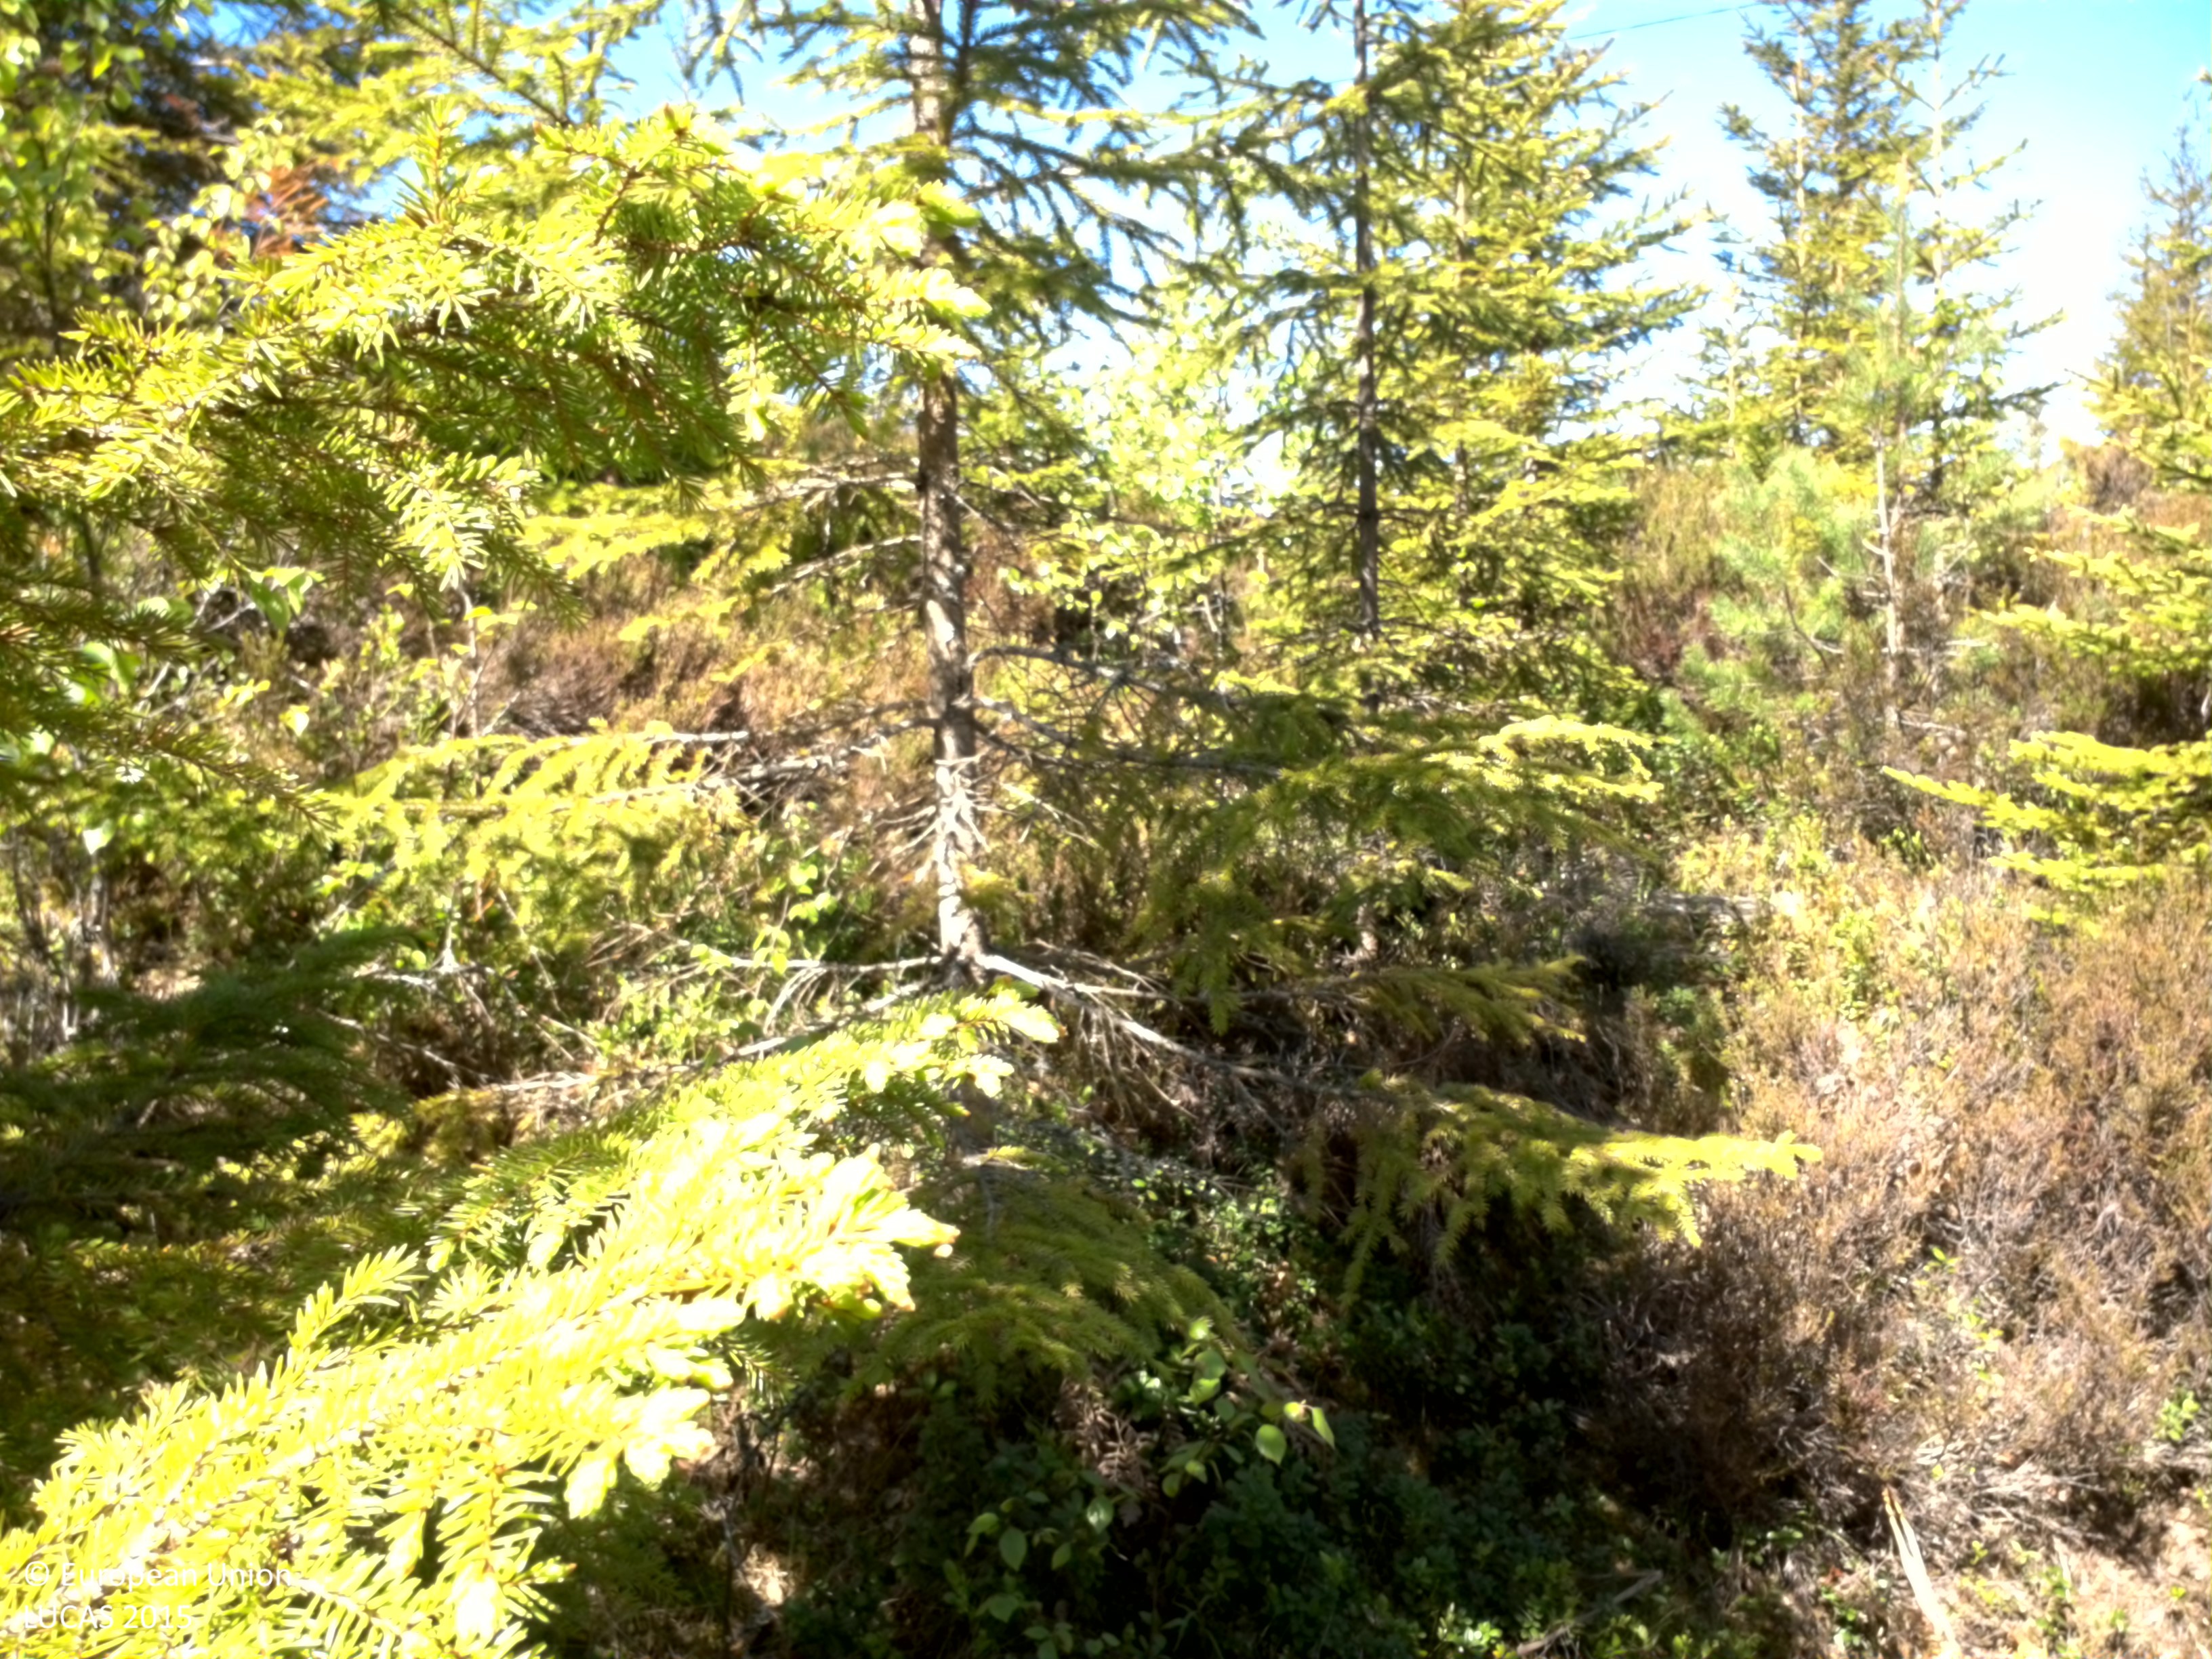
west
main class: Woodland
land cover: Spruce dominated coniferous woodland
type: boreal forest
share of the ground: 50 - 75 %
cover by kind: coniferous forest trees 50 %, shrubs 30 %, lichens and mosses 10 %, broadleaved forest trees 5 %, herbaceous plants 5 %
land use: Forestry
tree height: < 5 m
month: June
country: SE
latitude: 59.4038
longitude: 12.4071
